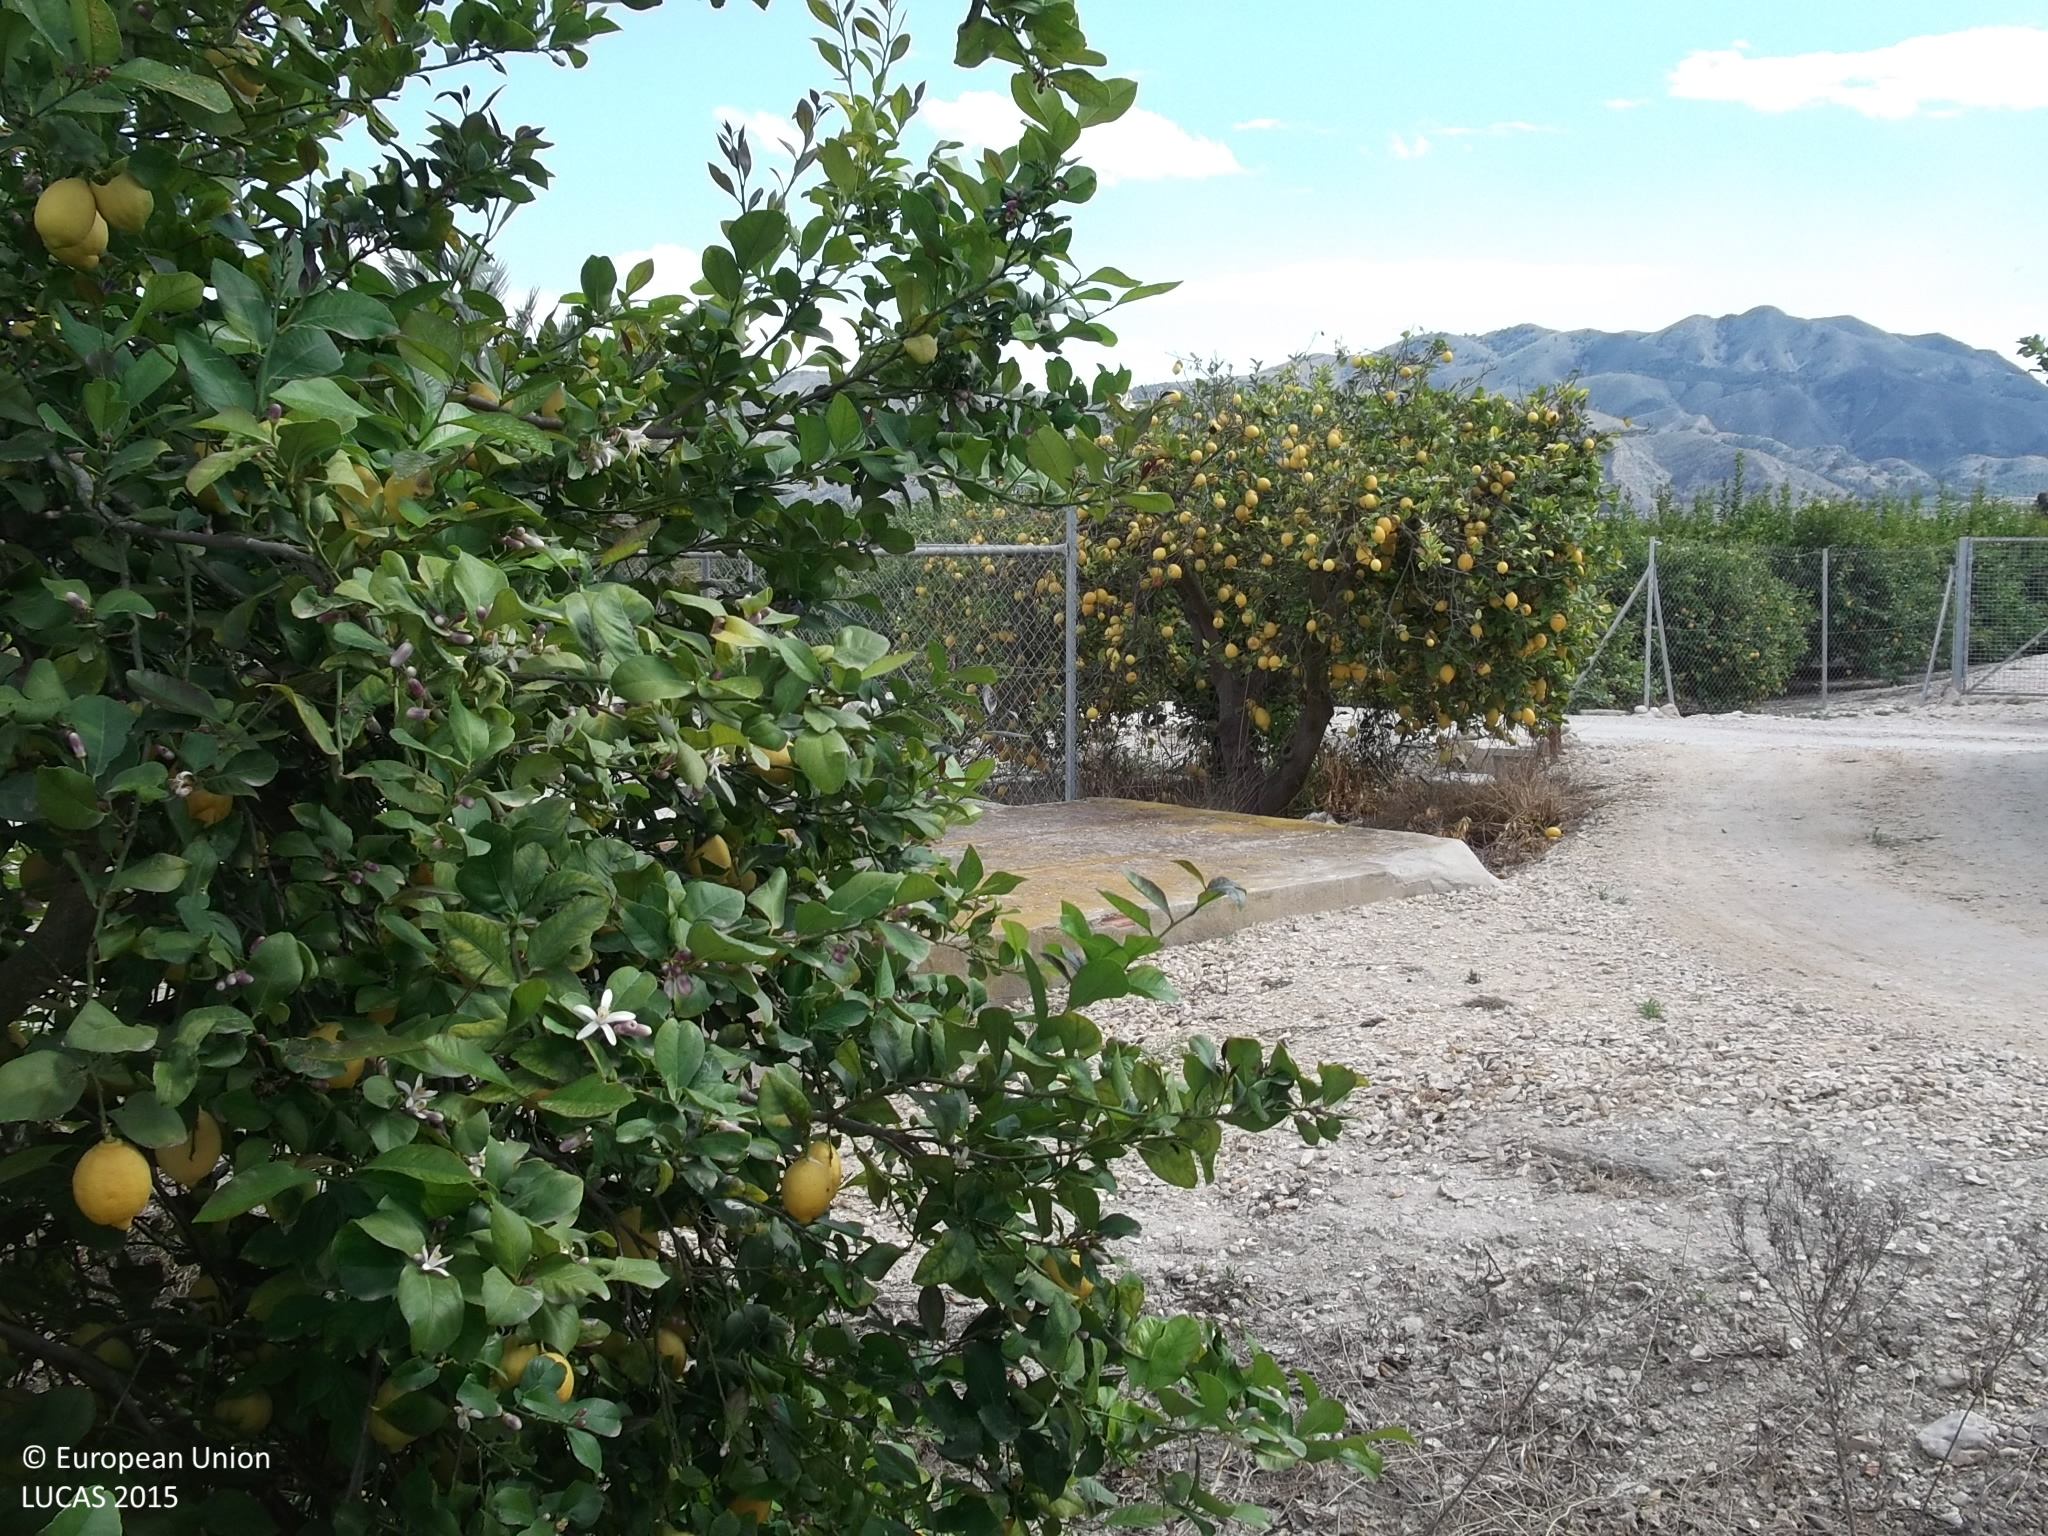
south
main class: Cropland
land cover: Other citrus fruit
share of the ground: 25 - 50 %
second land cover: Other bare soil
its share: > 75 %
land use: Agriculture (excluding fallow land and kitchen gardens)
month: April
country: ES
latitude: 38.1498
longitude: -0.9971
